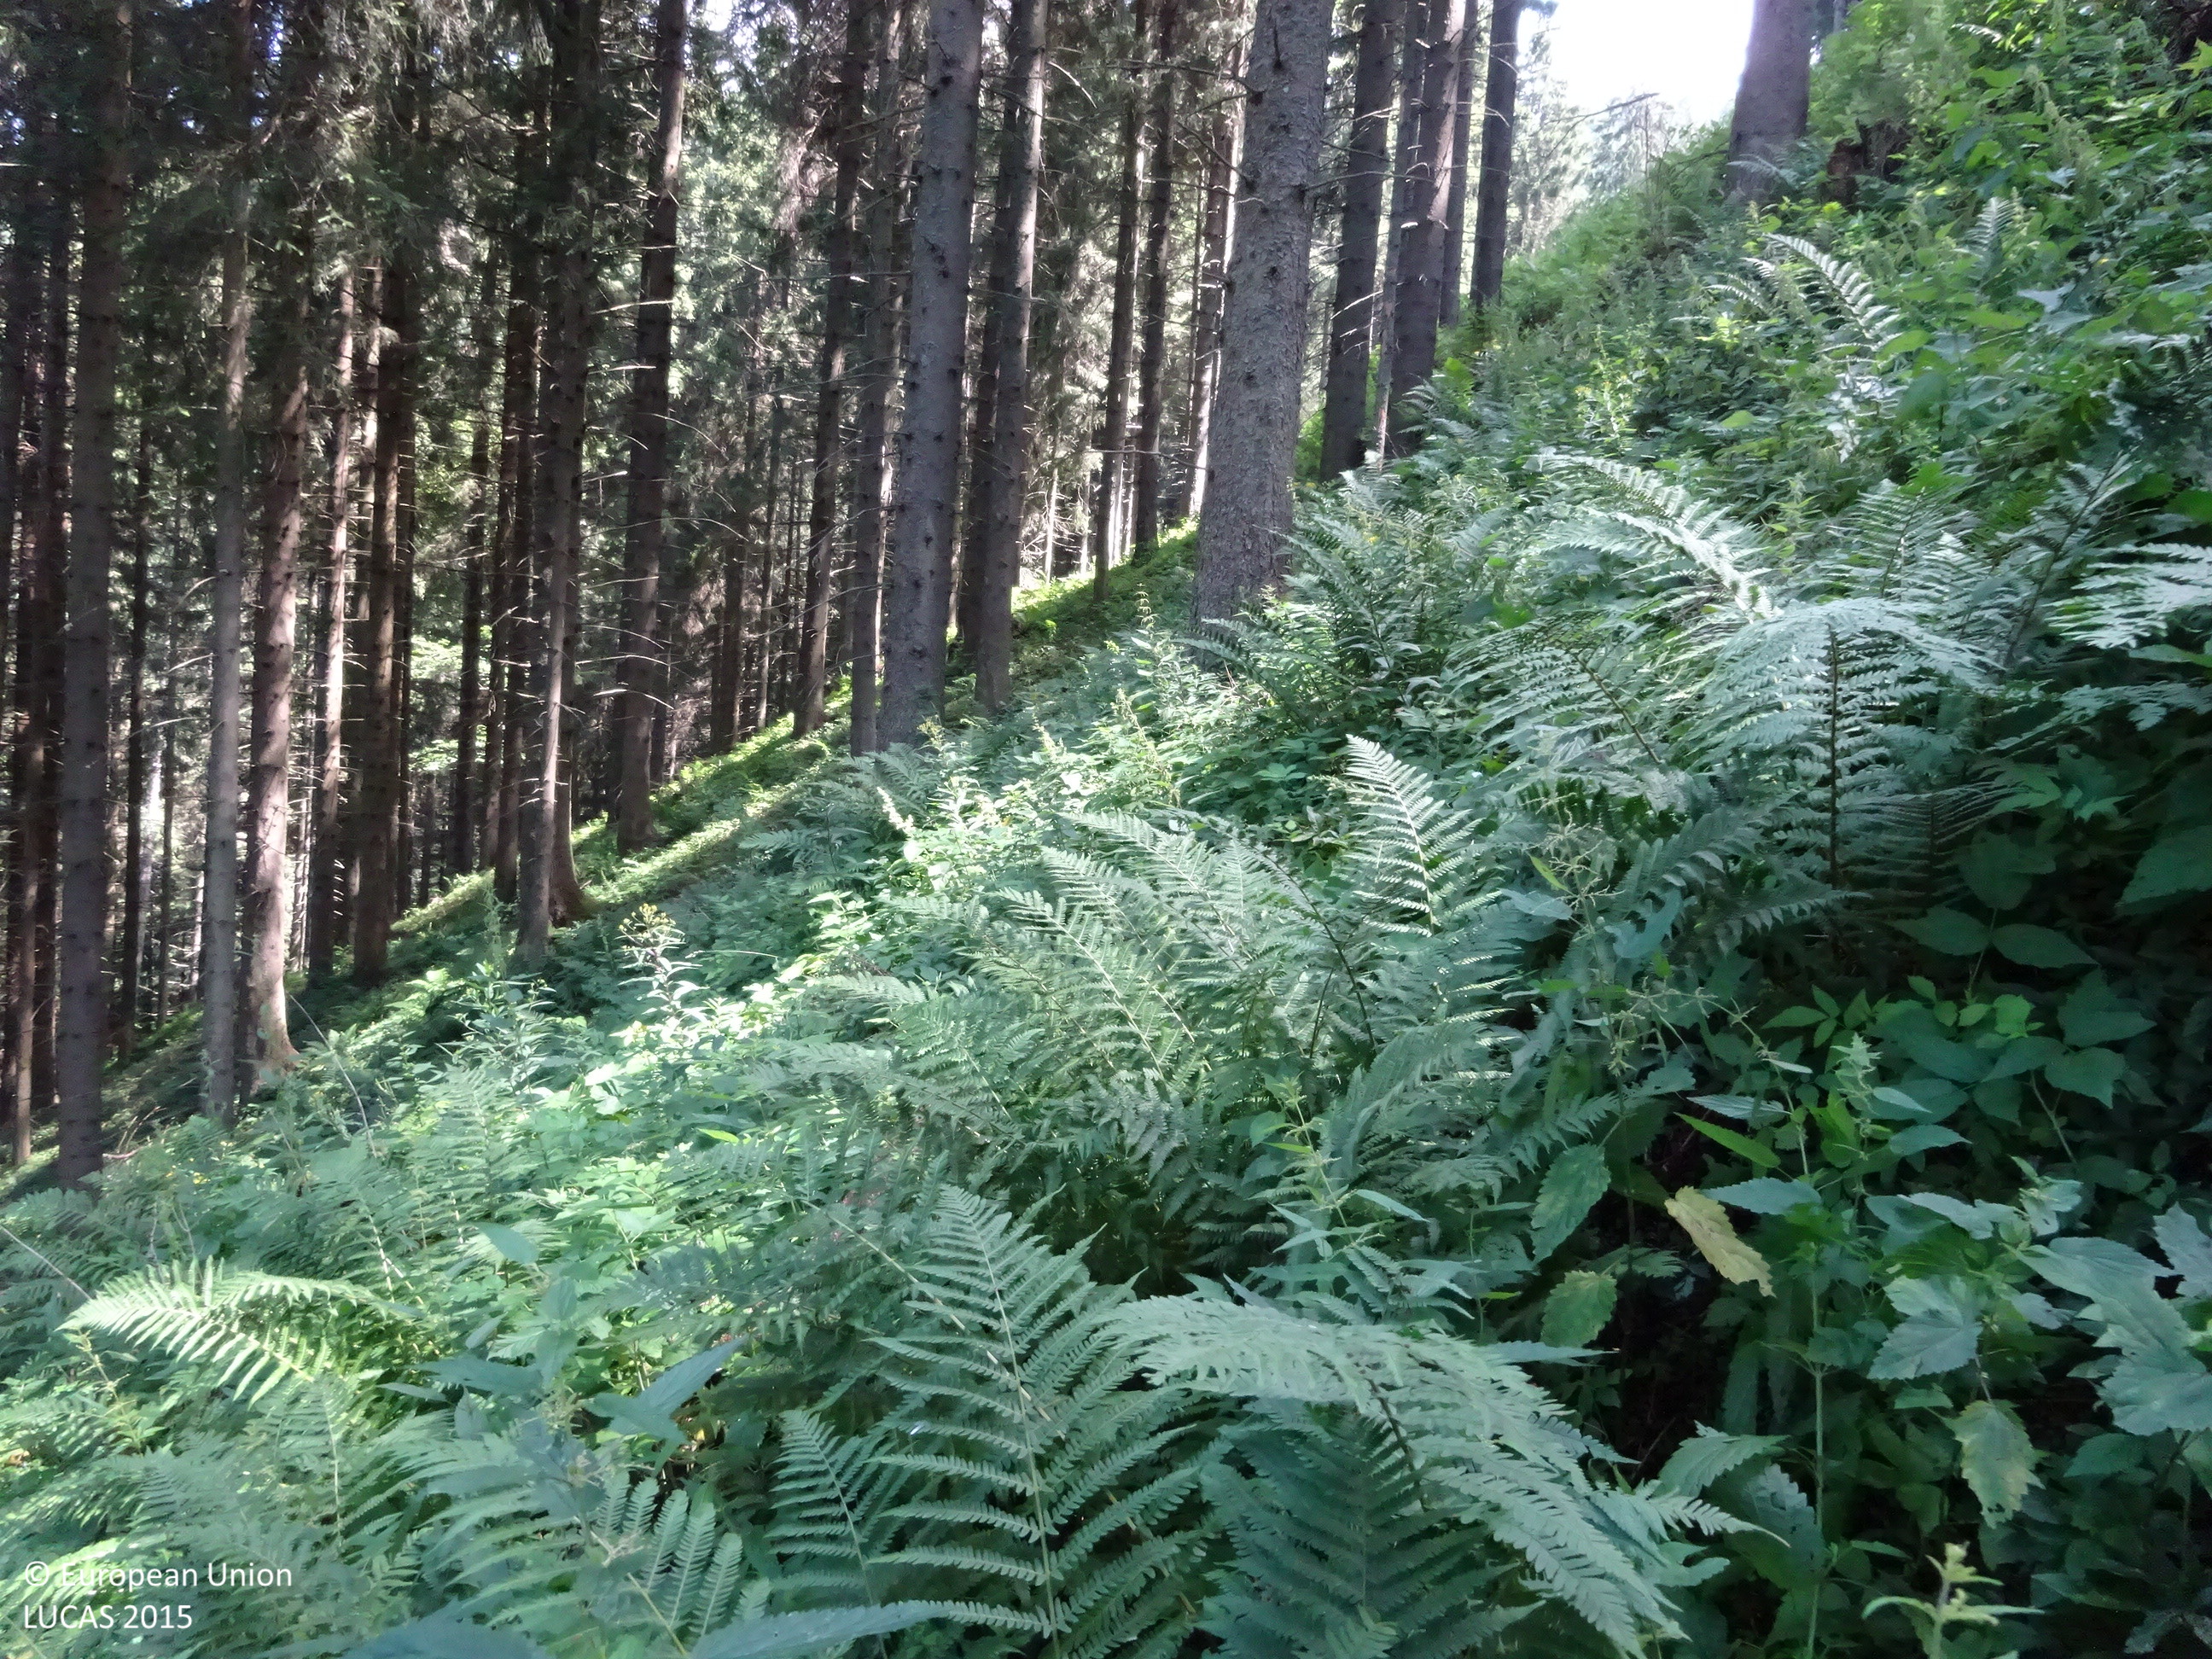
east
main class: Woodland
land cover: Spruce dominated coniferous woodland
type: alpine coniferous forest
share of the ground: > 75 %
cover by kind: coniferous forest trees 85 %, herbaceous plants 10 %, shrubs 5 %
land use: Forestry
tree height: > 5 m
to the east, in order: Spruce dominated coniferous woodland; Spruce dominated mixed woodland; Rivers and streams; Spruce dominated mixed woodland; Spruce dominated coniferous woodland; Spontaneously vegetated surfaces; Tracks; Spontaneously vegetated surfaces
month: August
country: AT
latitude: 47.3636
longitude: 15.5222
